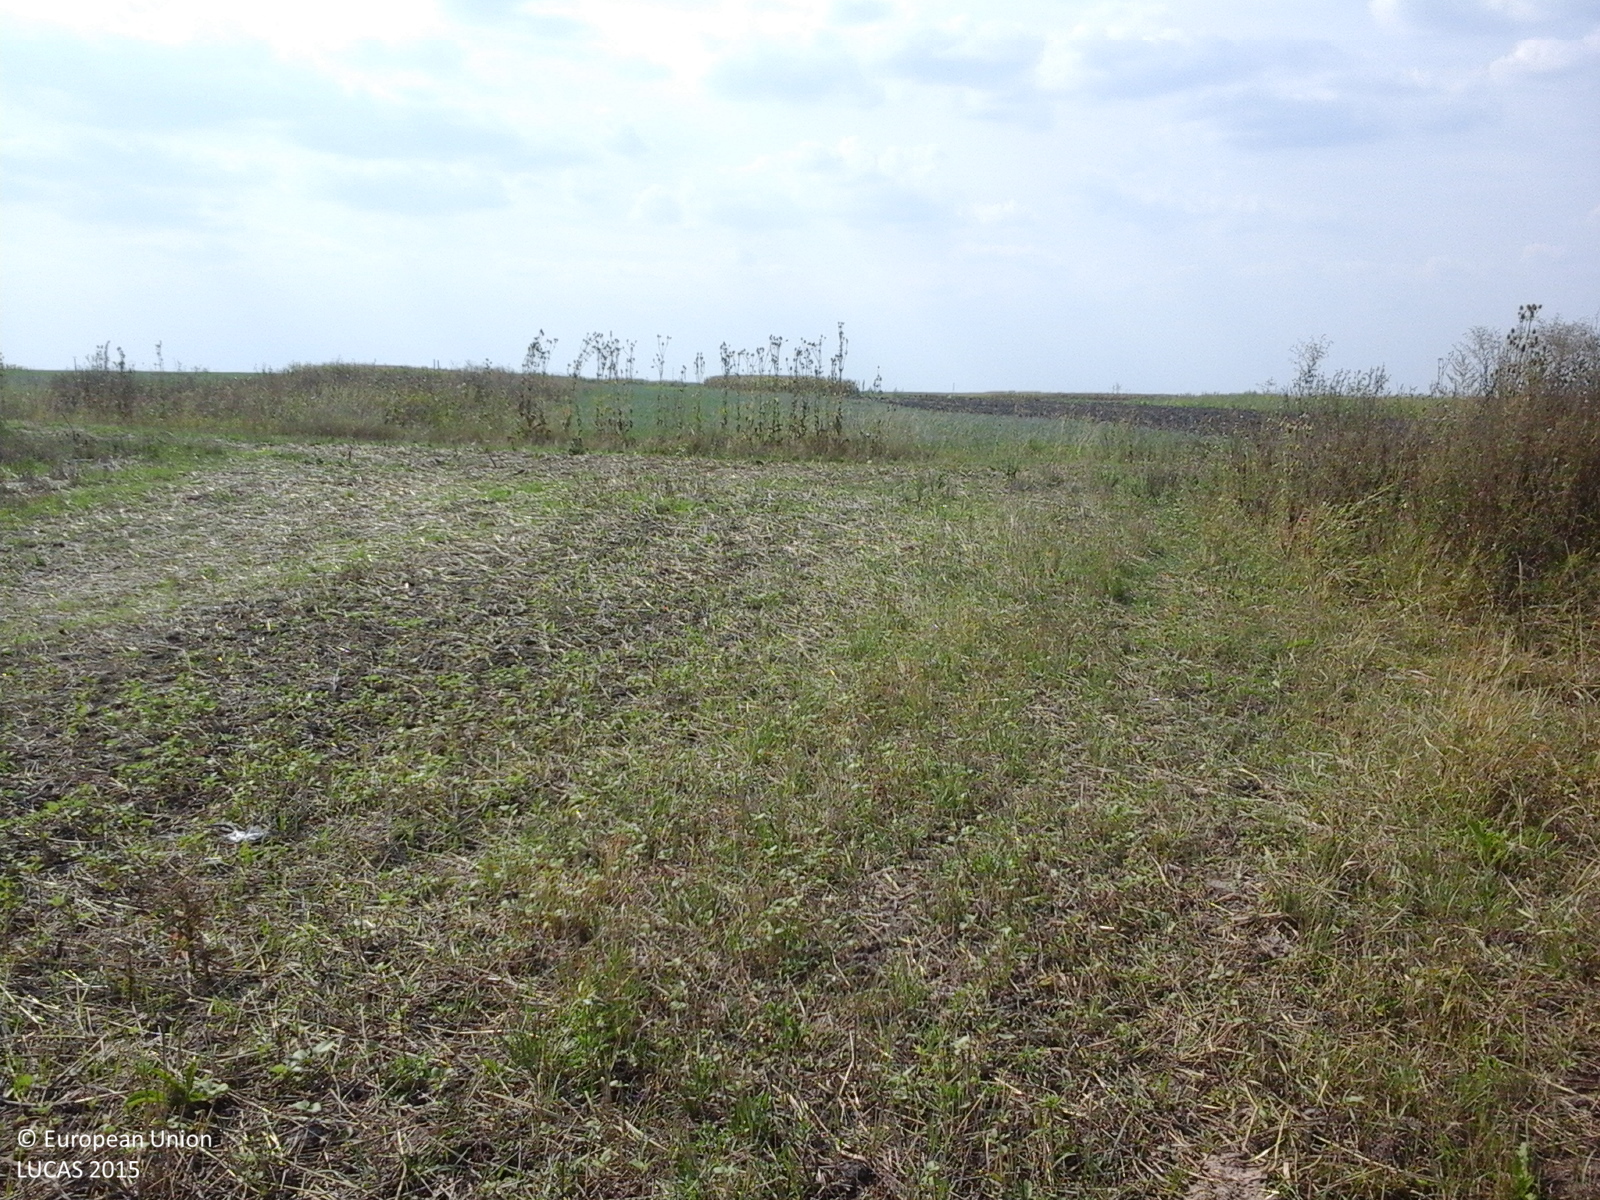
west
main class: Cropland
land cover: Common wheat
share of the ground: < 10 %
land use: Agriculture (excluding fallow land and kitchen gardens)
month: August
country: RO
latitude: 46.3964
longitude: 21.5478
